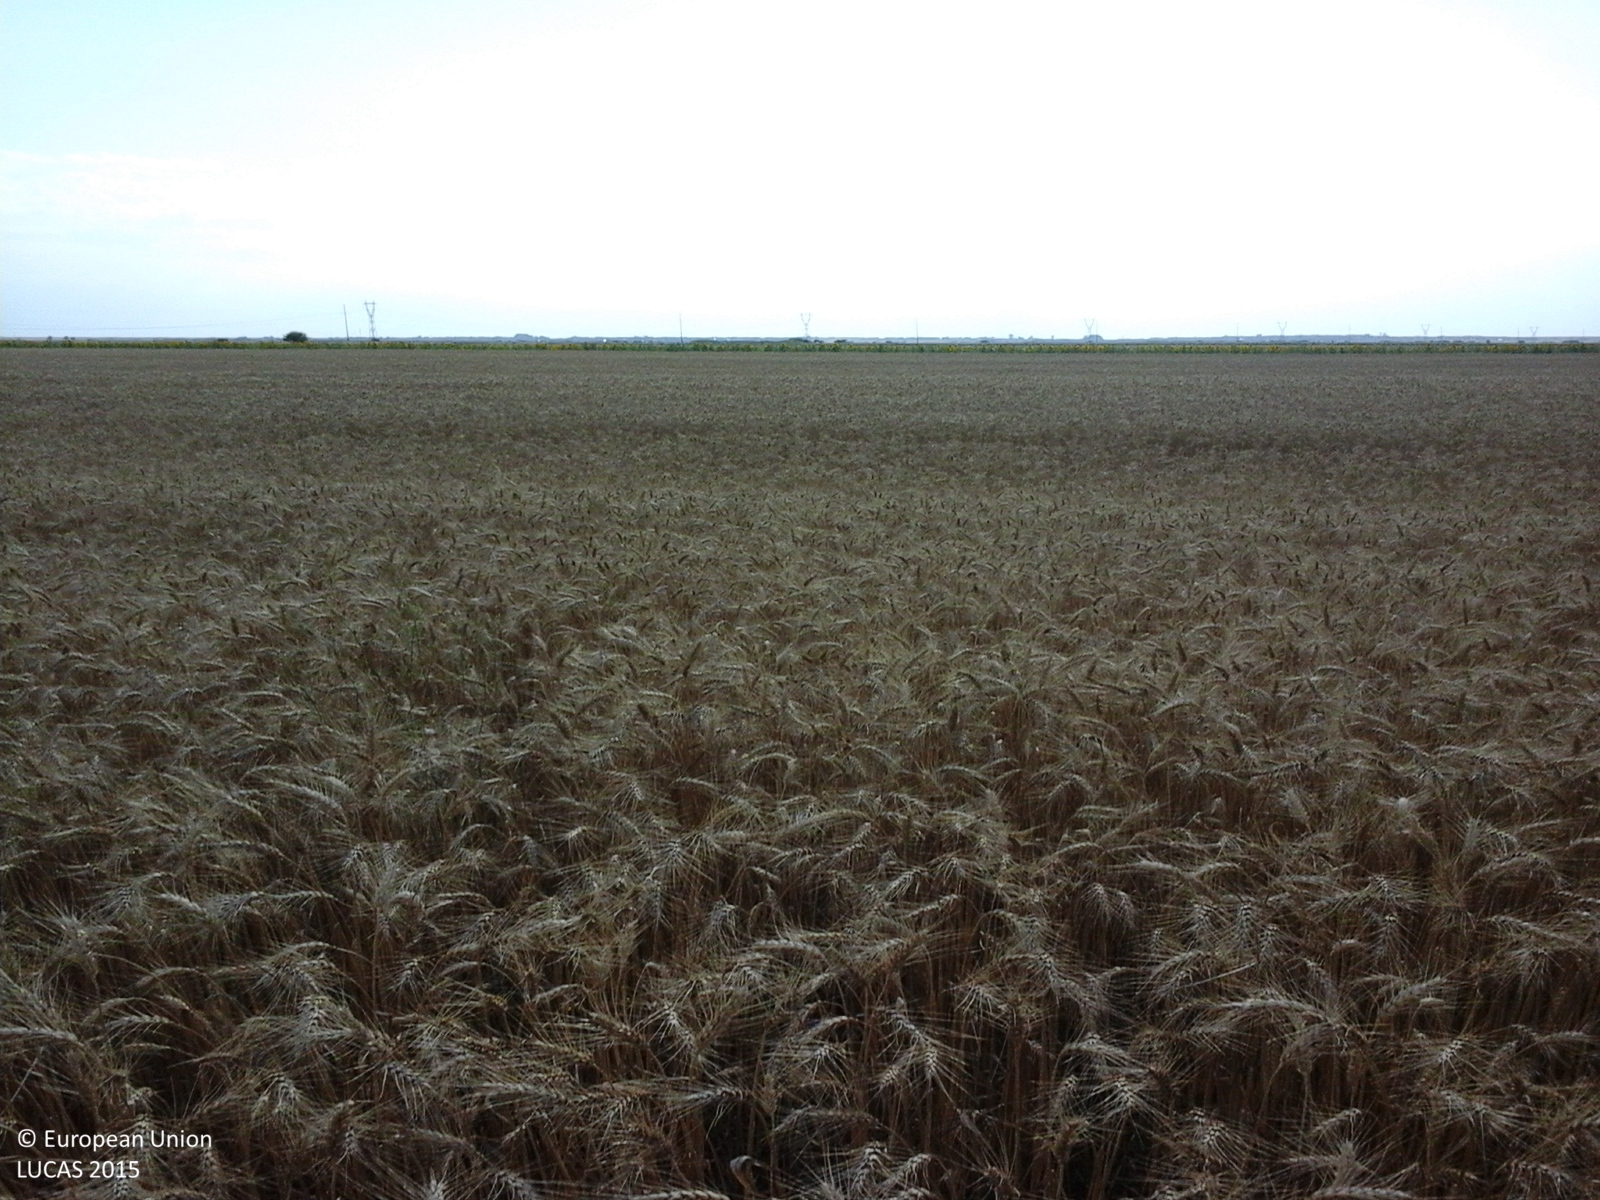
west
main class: Cropland
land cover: Common wheat
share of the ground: > 75 %
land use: Agriculture (excluding fallow land and kitchen gardens)
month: July
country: RO
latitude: 43.9152
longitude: 24.4735
